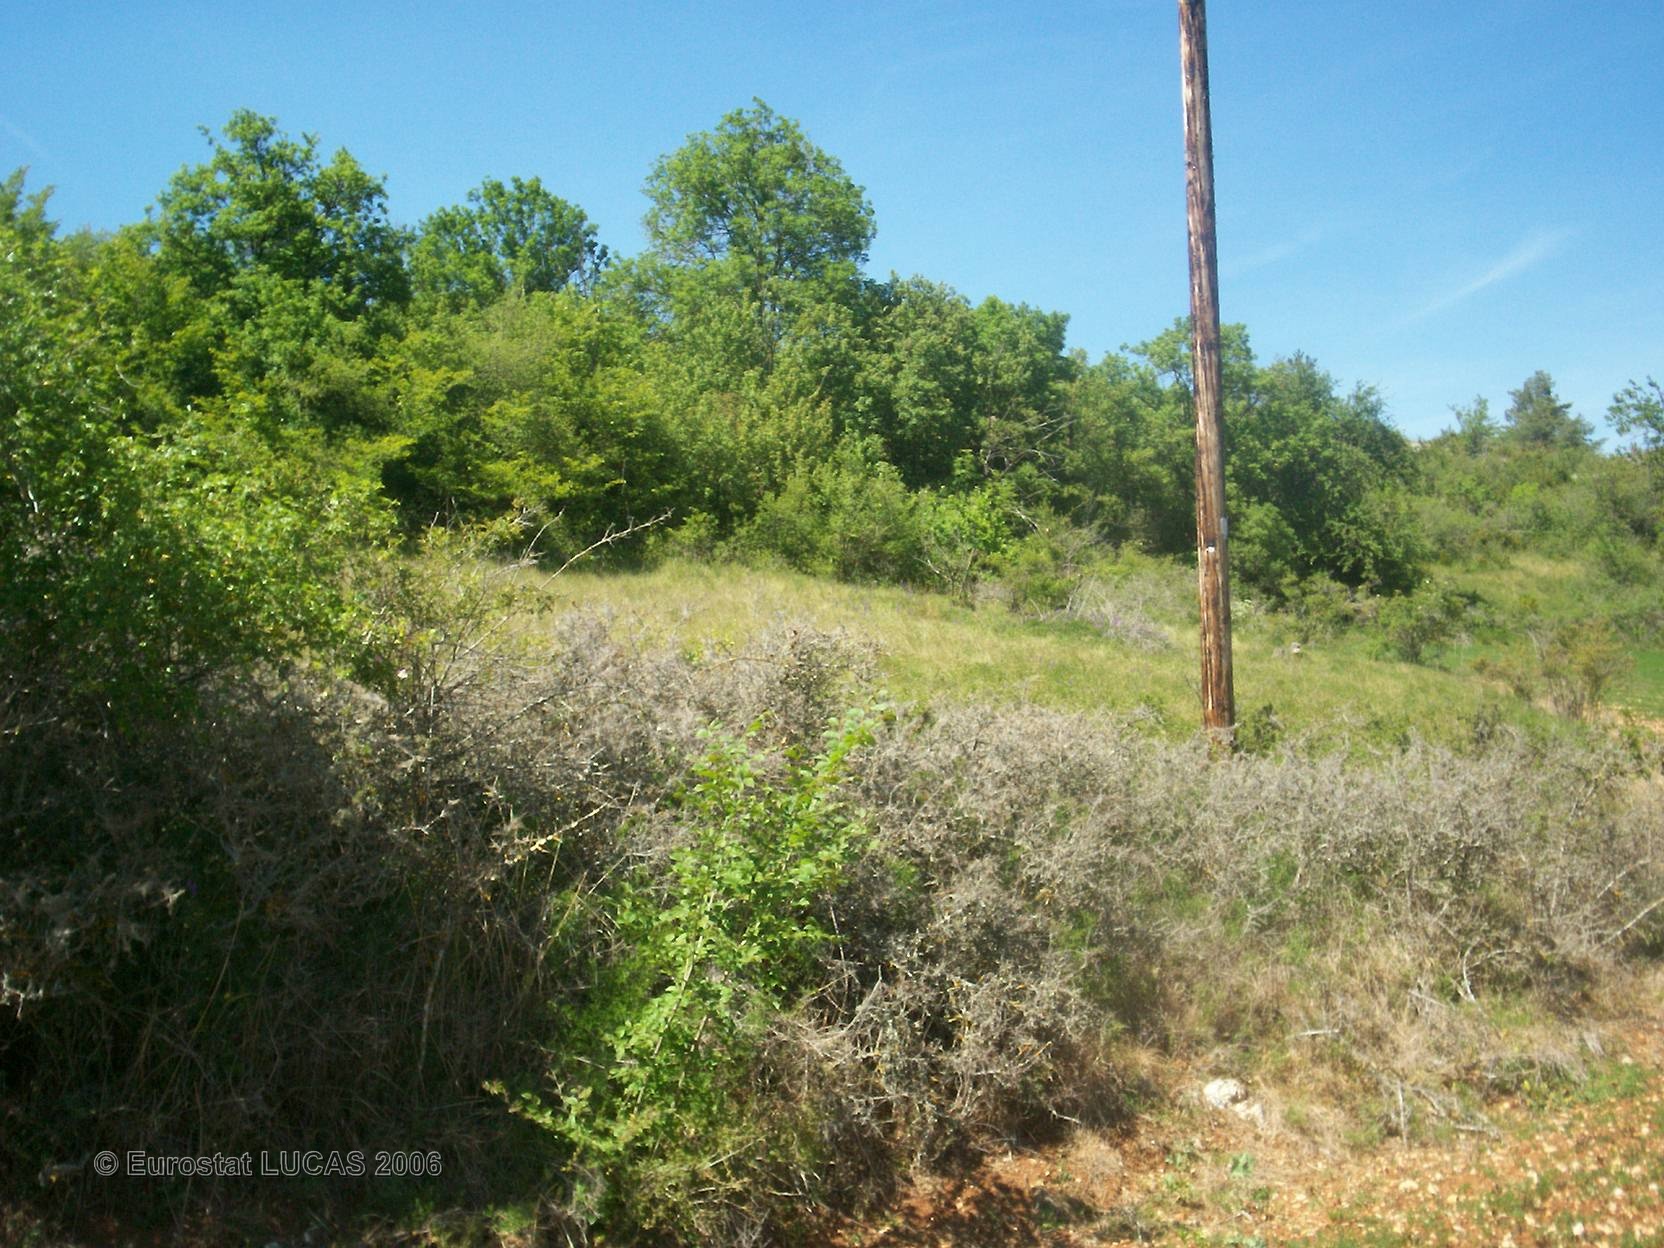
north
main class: Cropland
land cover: Clovers
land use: Agriculture (excluding fallow land and kitchen gardens)
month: June
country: FR
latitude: 44.3000
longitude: 3.3500
